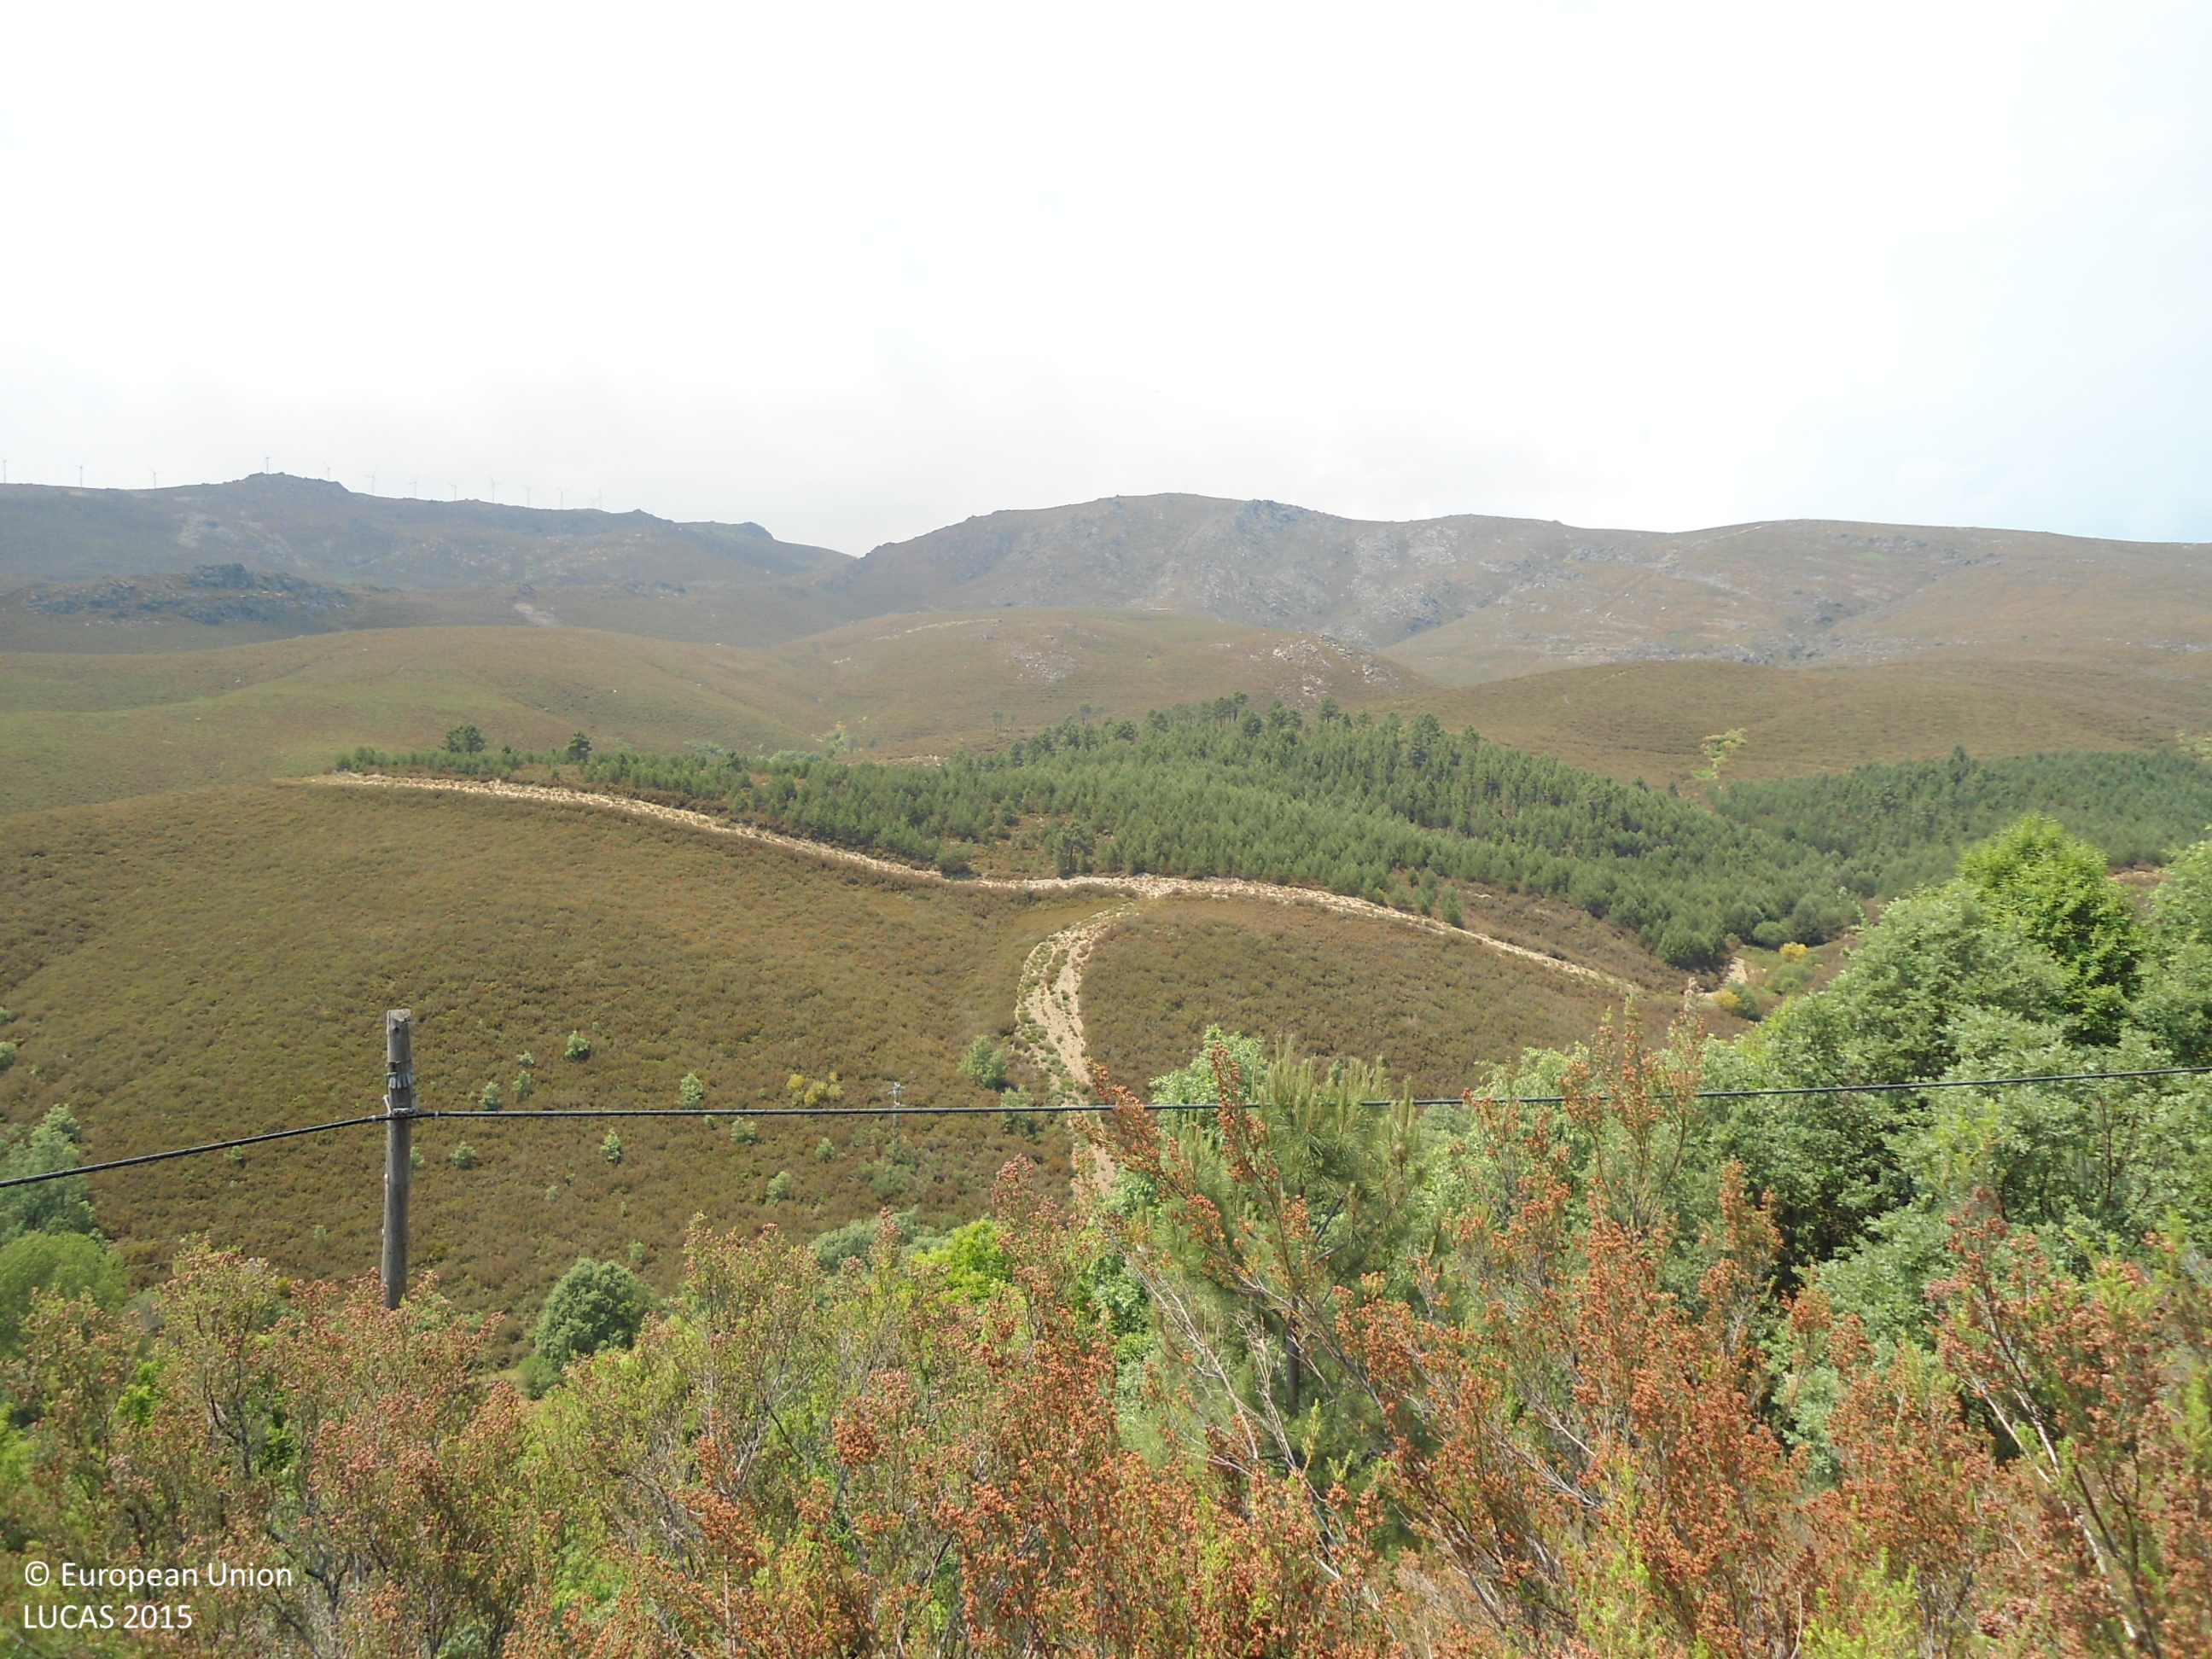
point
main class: Woodland
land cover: Pine dominated coniferous woodland
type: coniferous forest of the mediterranean region
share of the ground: > 75 %
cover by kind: coniferous forest trees 80 %, shrubs 20 %
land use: Forestry
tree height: > 5 m
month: June
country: ES
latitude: 41.9901
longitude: -6.7122
